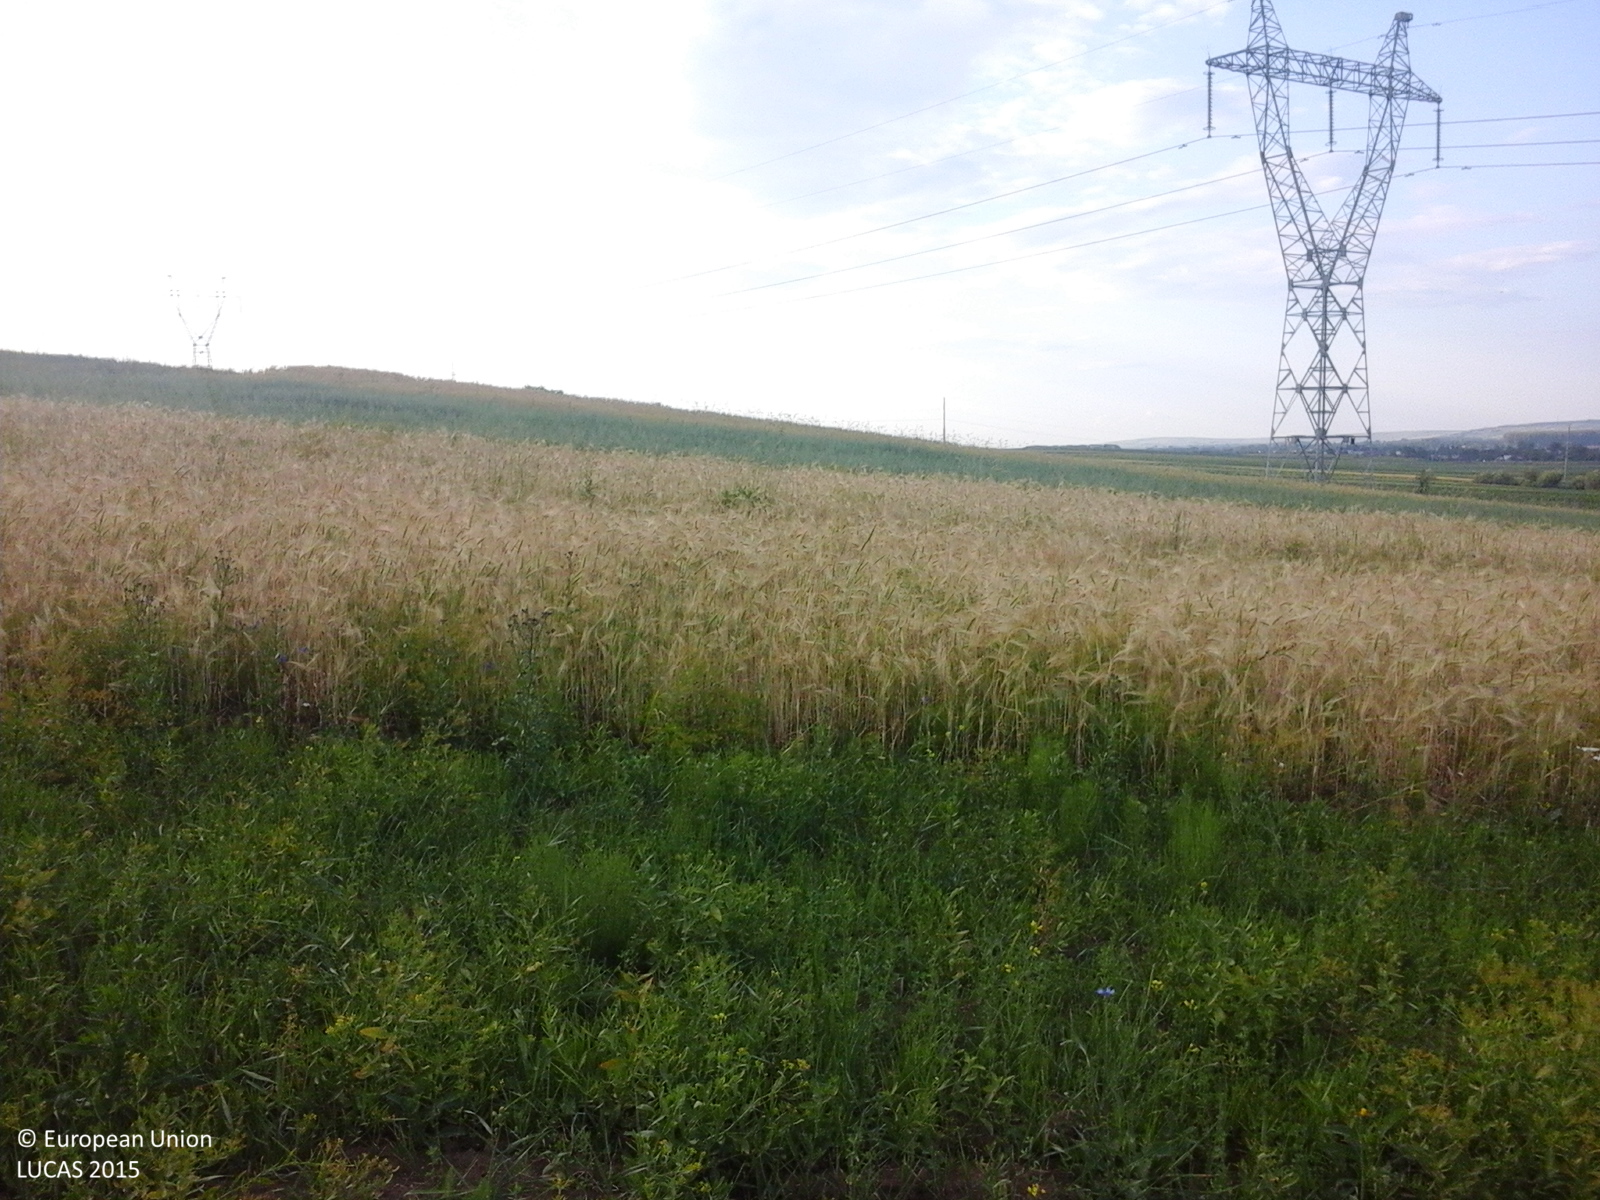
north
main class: Cropland
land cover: Other leguminous and mixtures for fodder
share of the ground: > 75 %
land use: Agriculture (excluding fallow land and kitchen gardens)
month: June
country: RO
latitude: 47.4957
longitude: 26.5365
